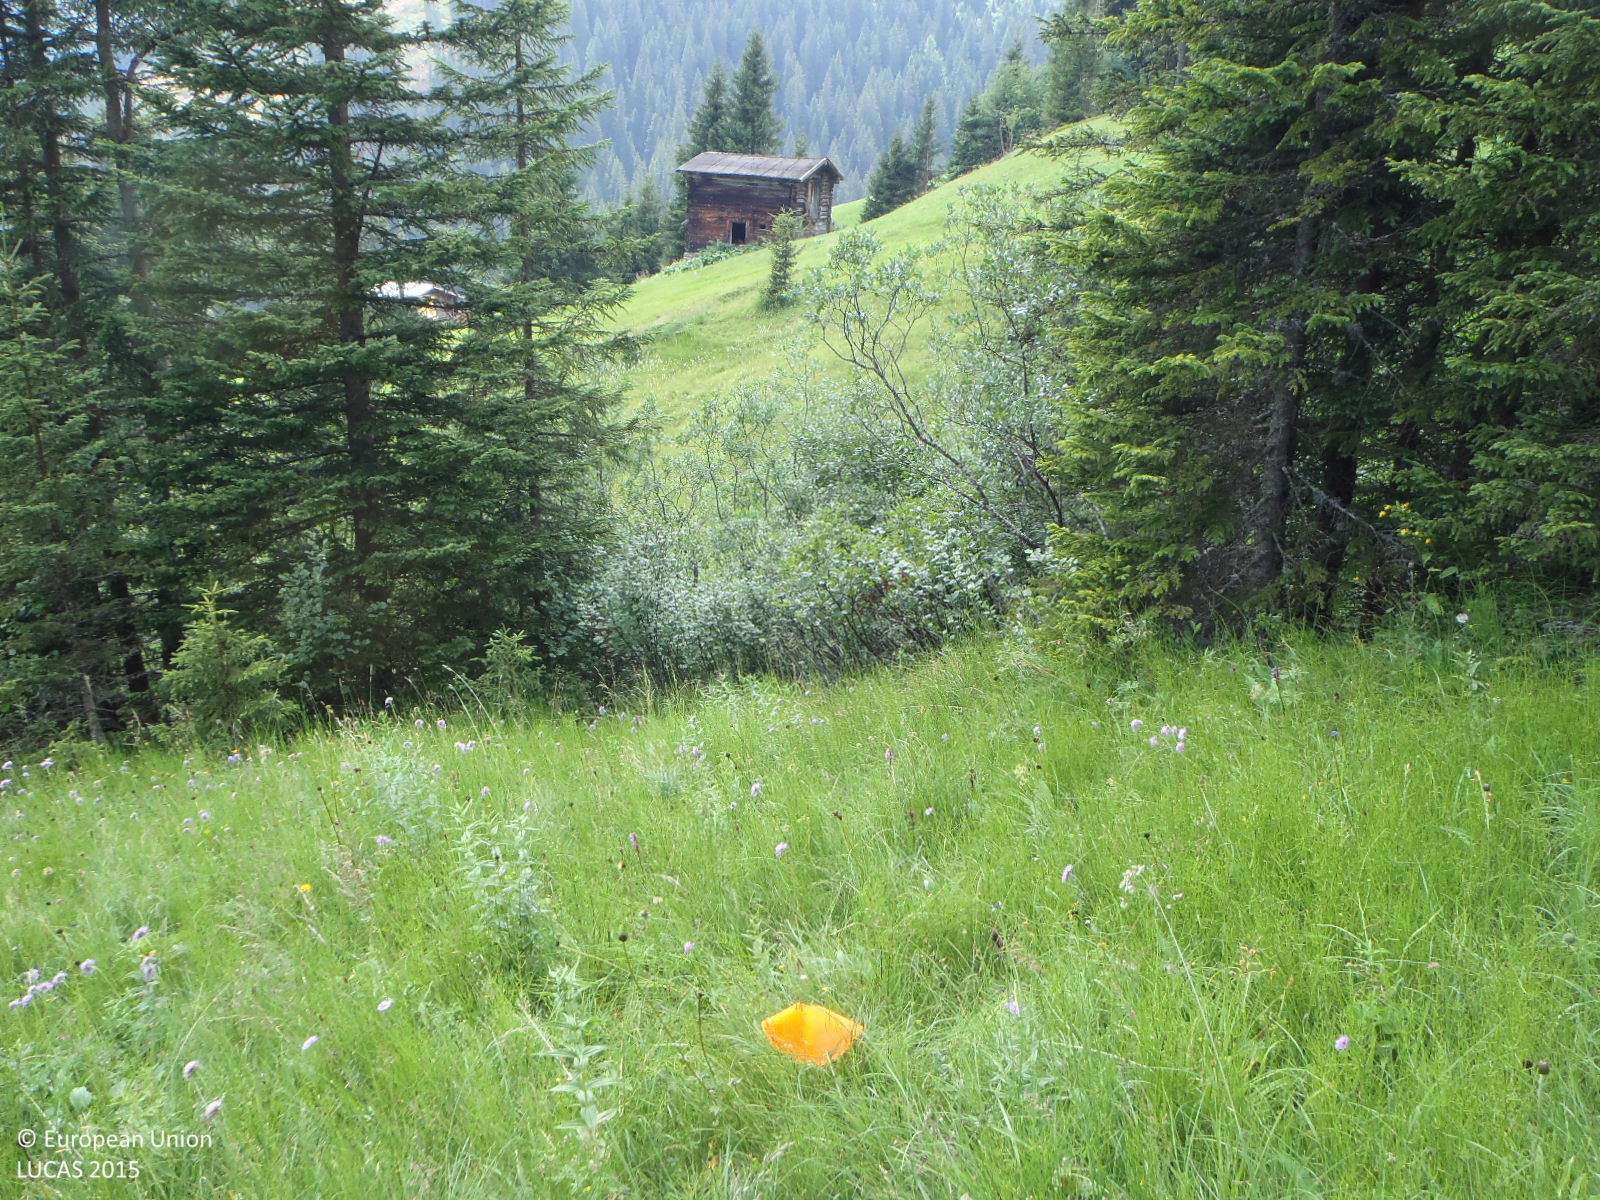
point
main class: Grassland
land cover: Grassland without tree/shrub cover
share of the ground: > 75 %
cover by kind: herbaceous plants 100 %
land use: Agriculture (excluding fallow land and kitchen gardens)
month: July
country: AT
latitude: 47.1838
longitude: 11.7272
